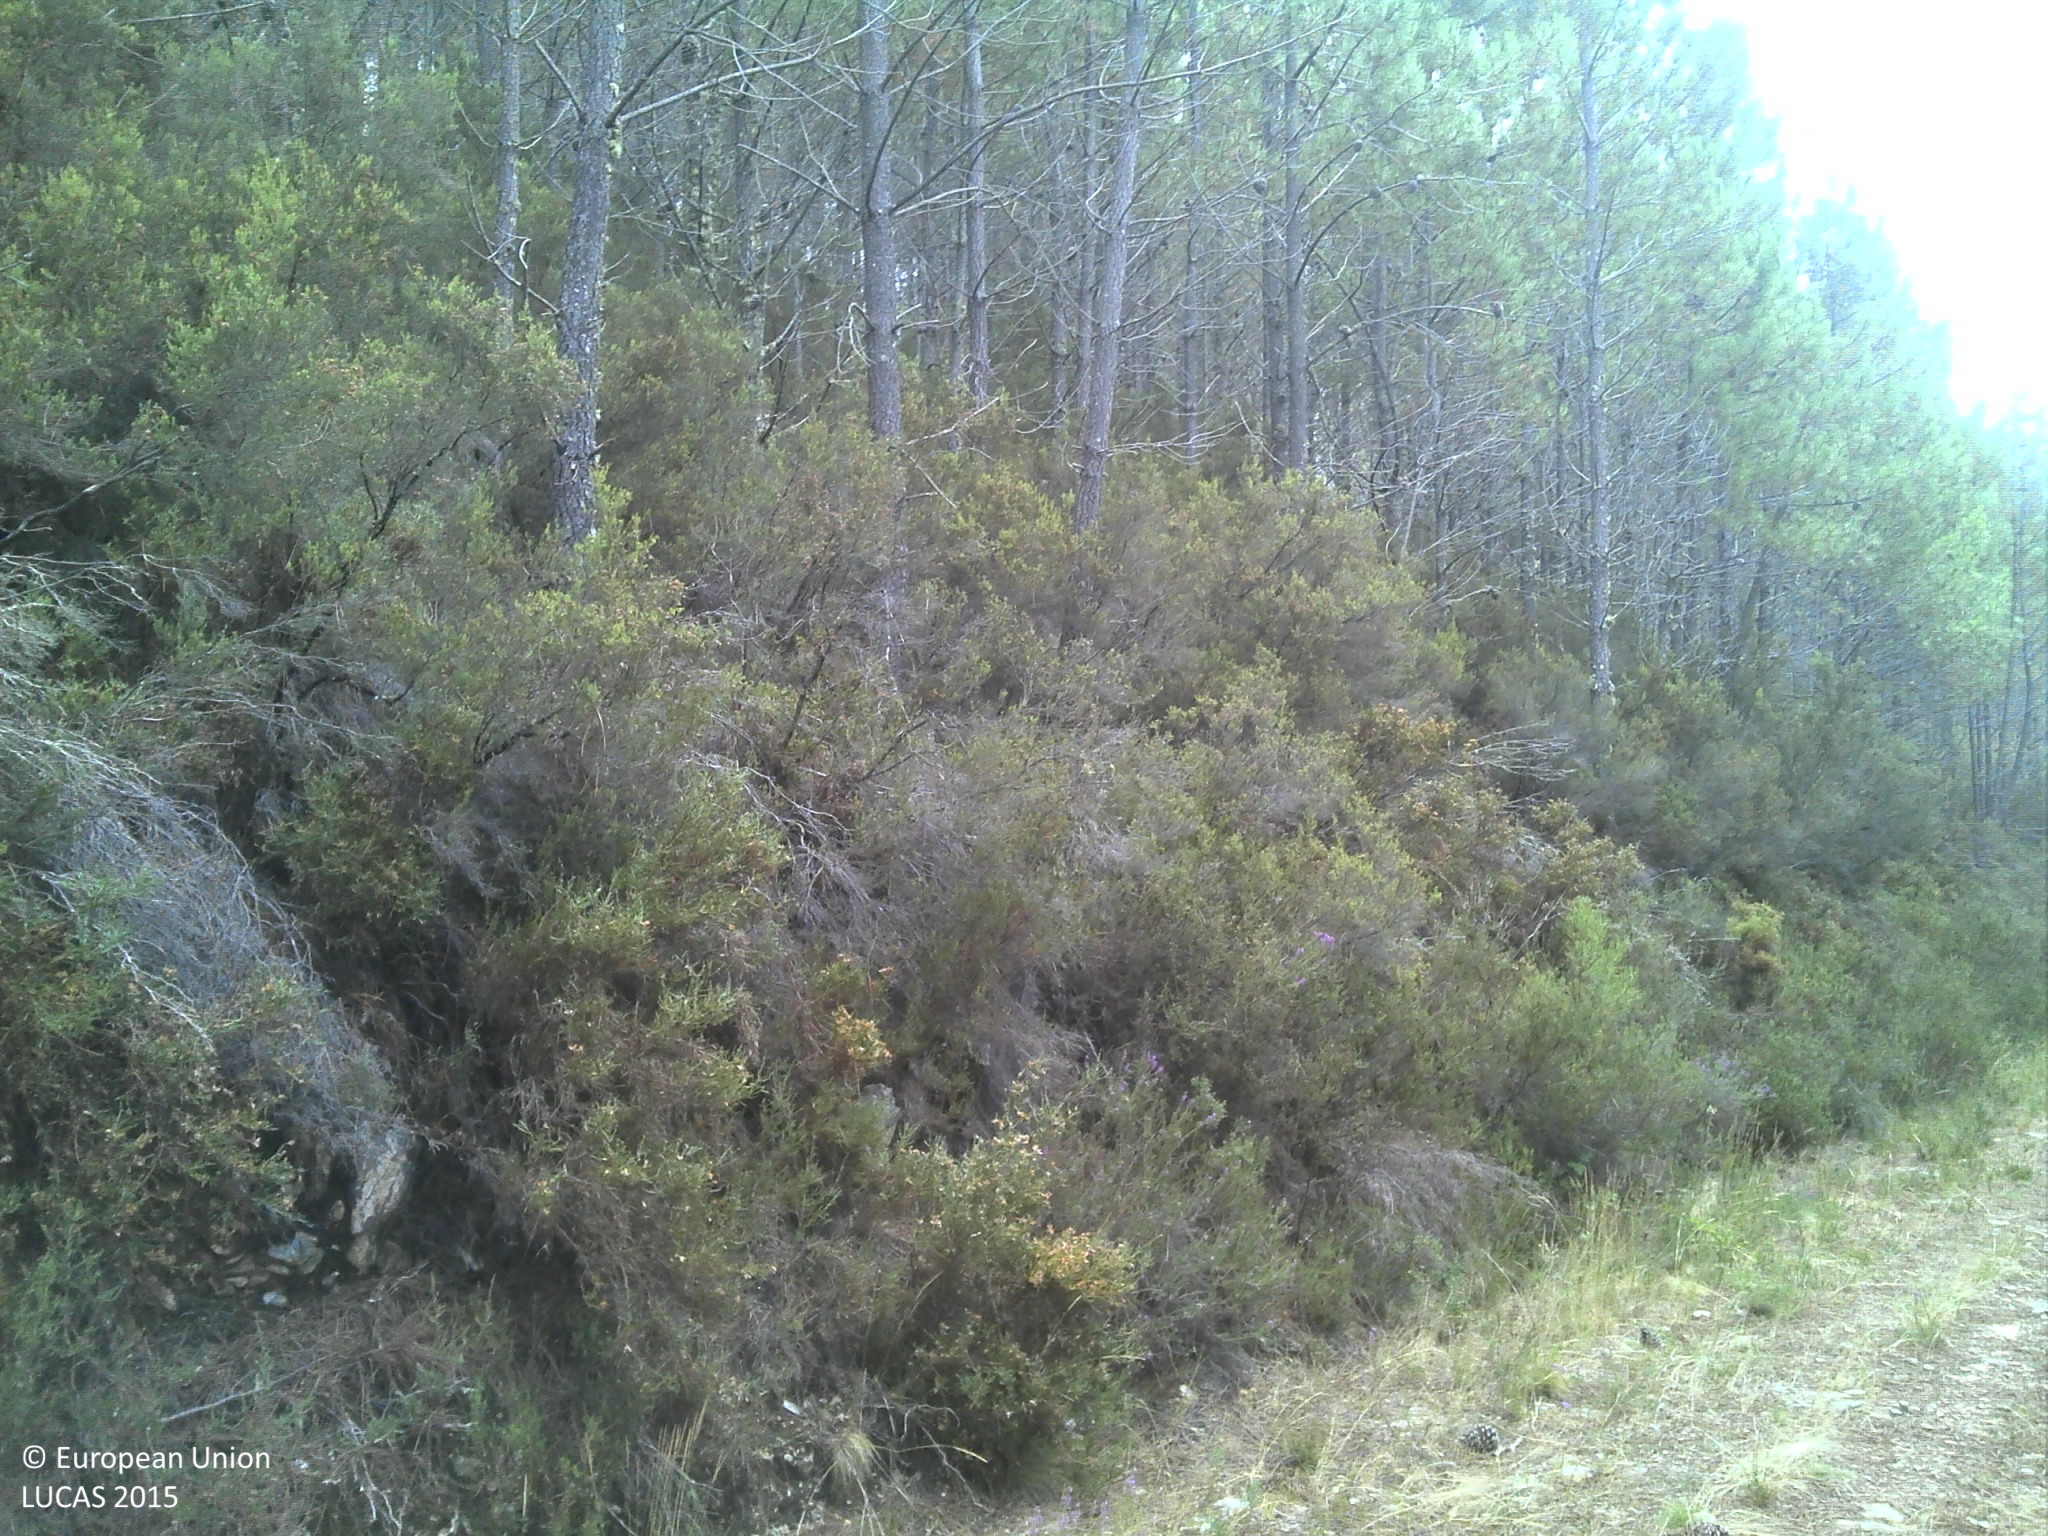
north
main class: Woodland
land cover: Pine dominated coniferous woodland
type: coniferous forest of the mediterranean region
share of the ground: 50 - 75 %
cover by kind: coniferous forest trees 70 %, shrubs 25 %, unconsolidated bare surface 5 %
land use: Forestry
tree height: > 5 m
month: July
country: PT
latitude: 40.2361
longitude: -7.8761
